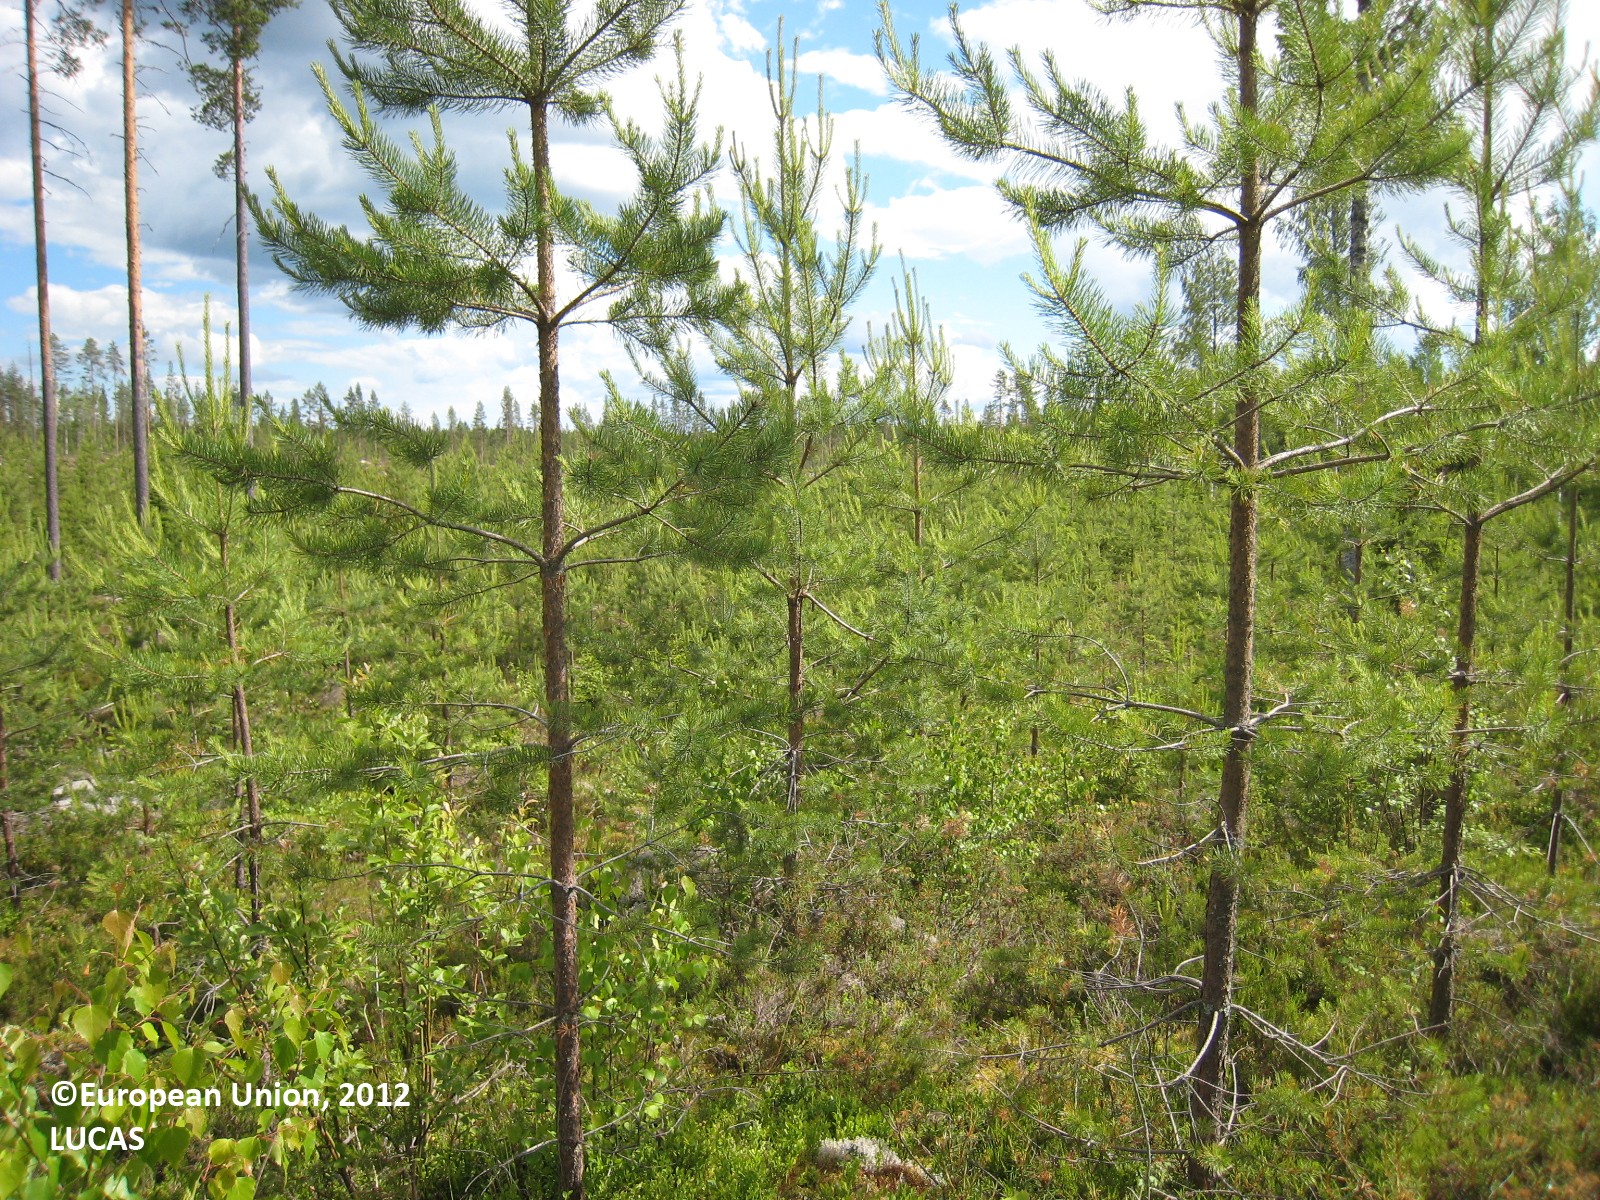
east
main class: Woodland
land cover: Pine dominated mixed woodland
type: boreal forest
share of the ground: 50 - 75 %
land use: Forestry
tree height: < 5 m
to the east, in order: Pine dominated mixed woodland; Pine dominated coniferous woodland; Other bare soil; Shrubland without tree cover; Other bare soil; Shrubland without tree cover
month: July
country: FI
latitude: 62.8351
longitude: 25.6818
